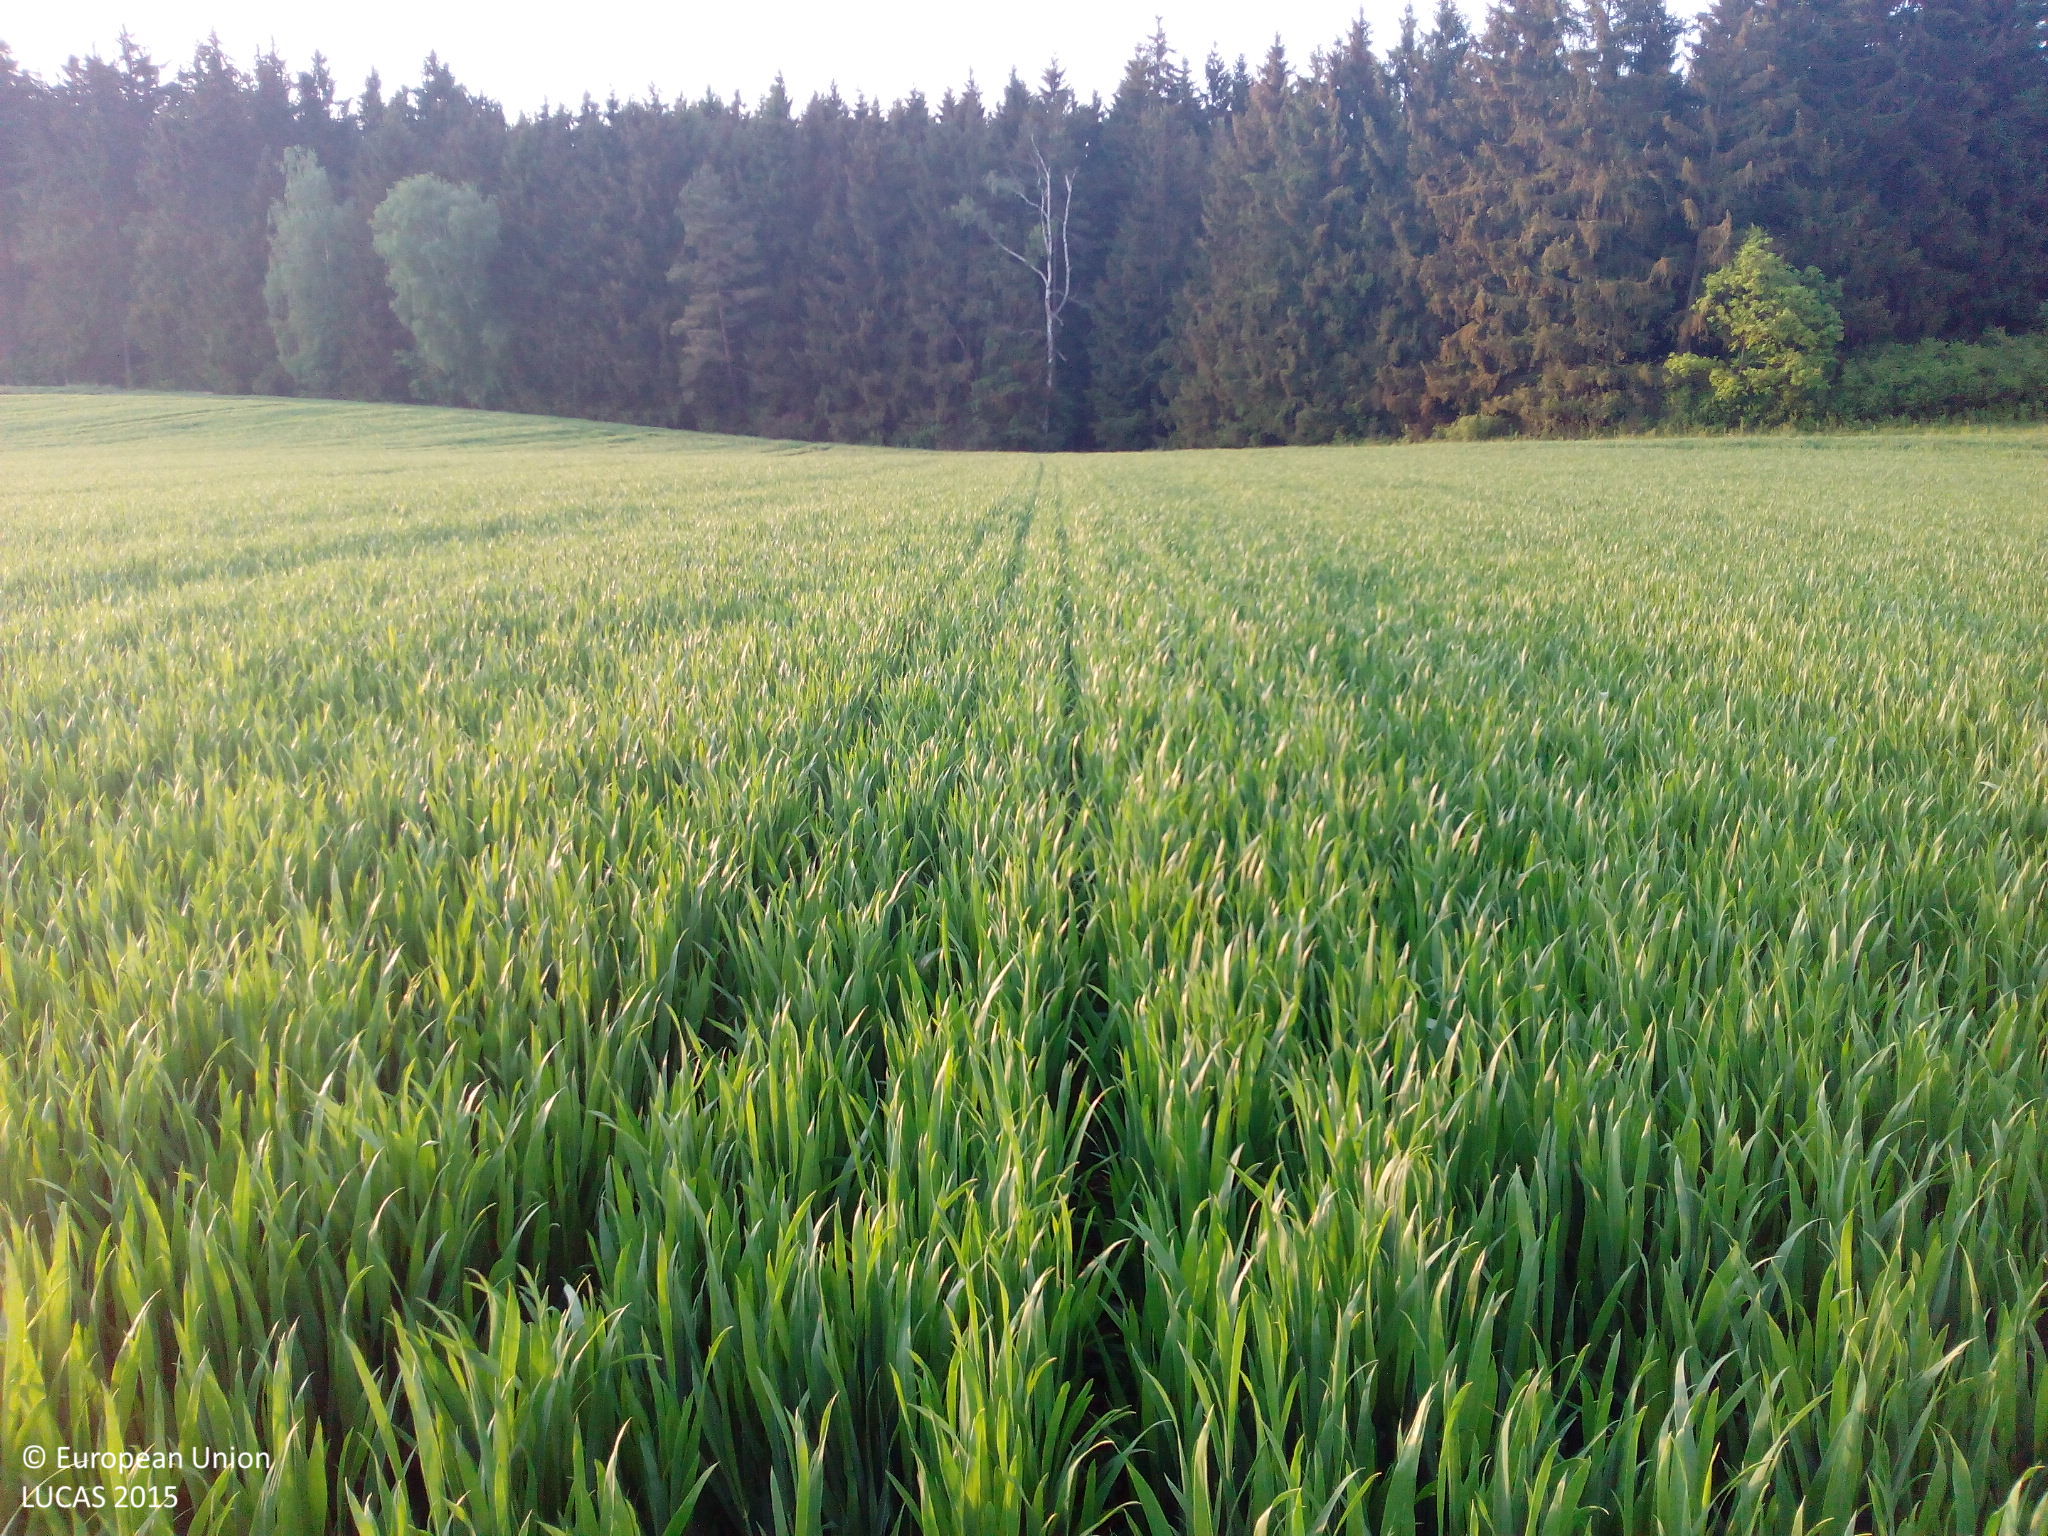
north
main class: Cropland
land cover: Common wheat
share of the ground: > 75 %
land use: Agriculture (excluding fallow land and kitchen gardens)
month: May
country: DE
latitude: 48.9693
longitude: 11.4884
